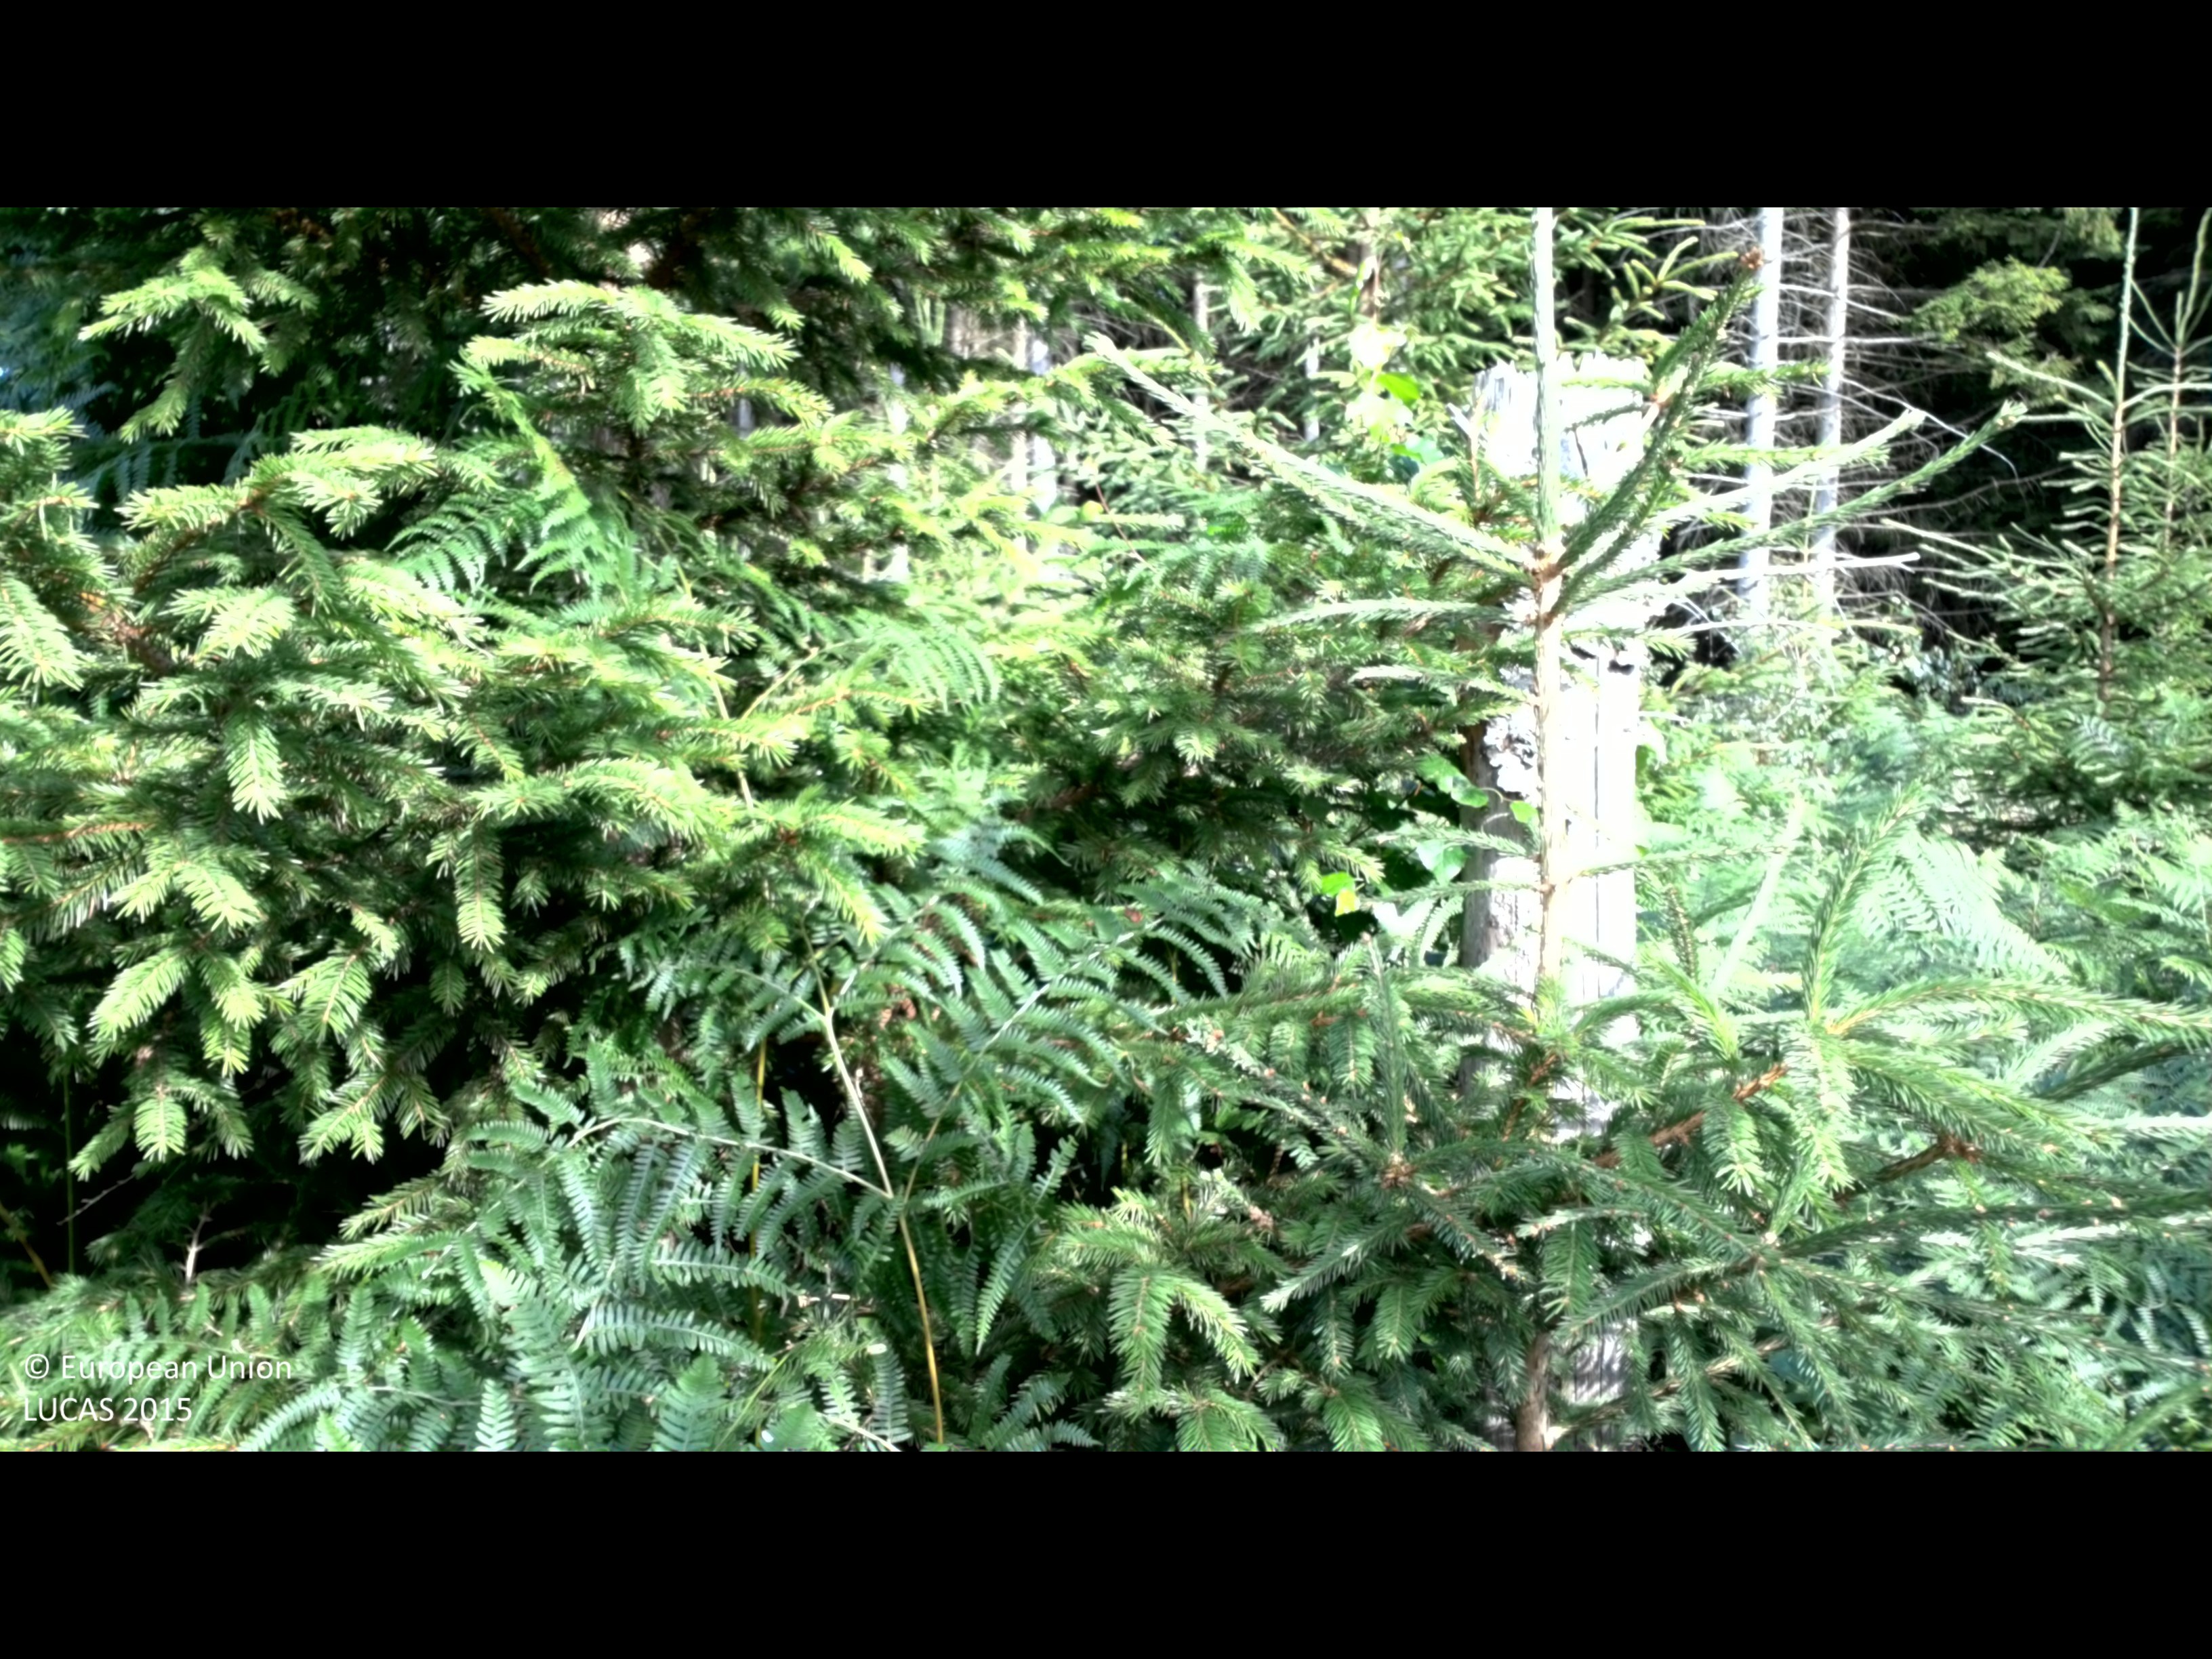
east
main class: Woodland
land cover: Spruce dominated mixed woodland
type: boreal forest
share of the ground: 50 - 75 %
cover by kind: herbaceous plants 50 %, coniferous forest trees 35 %, broadleaved forest trees 15 %
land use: Forestry
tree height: < 5 m
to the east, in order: Spruce dominated mixed woodland; Spruce dominated coniferous woodland; Broadleaved woodland
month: August
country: SE
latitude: 56.2194
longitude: 15.7896
